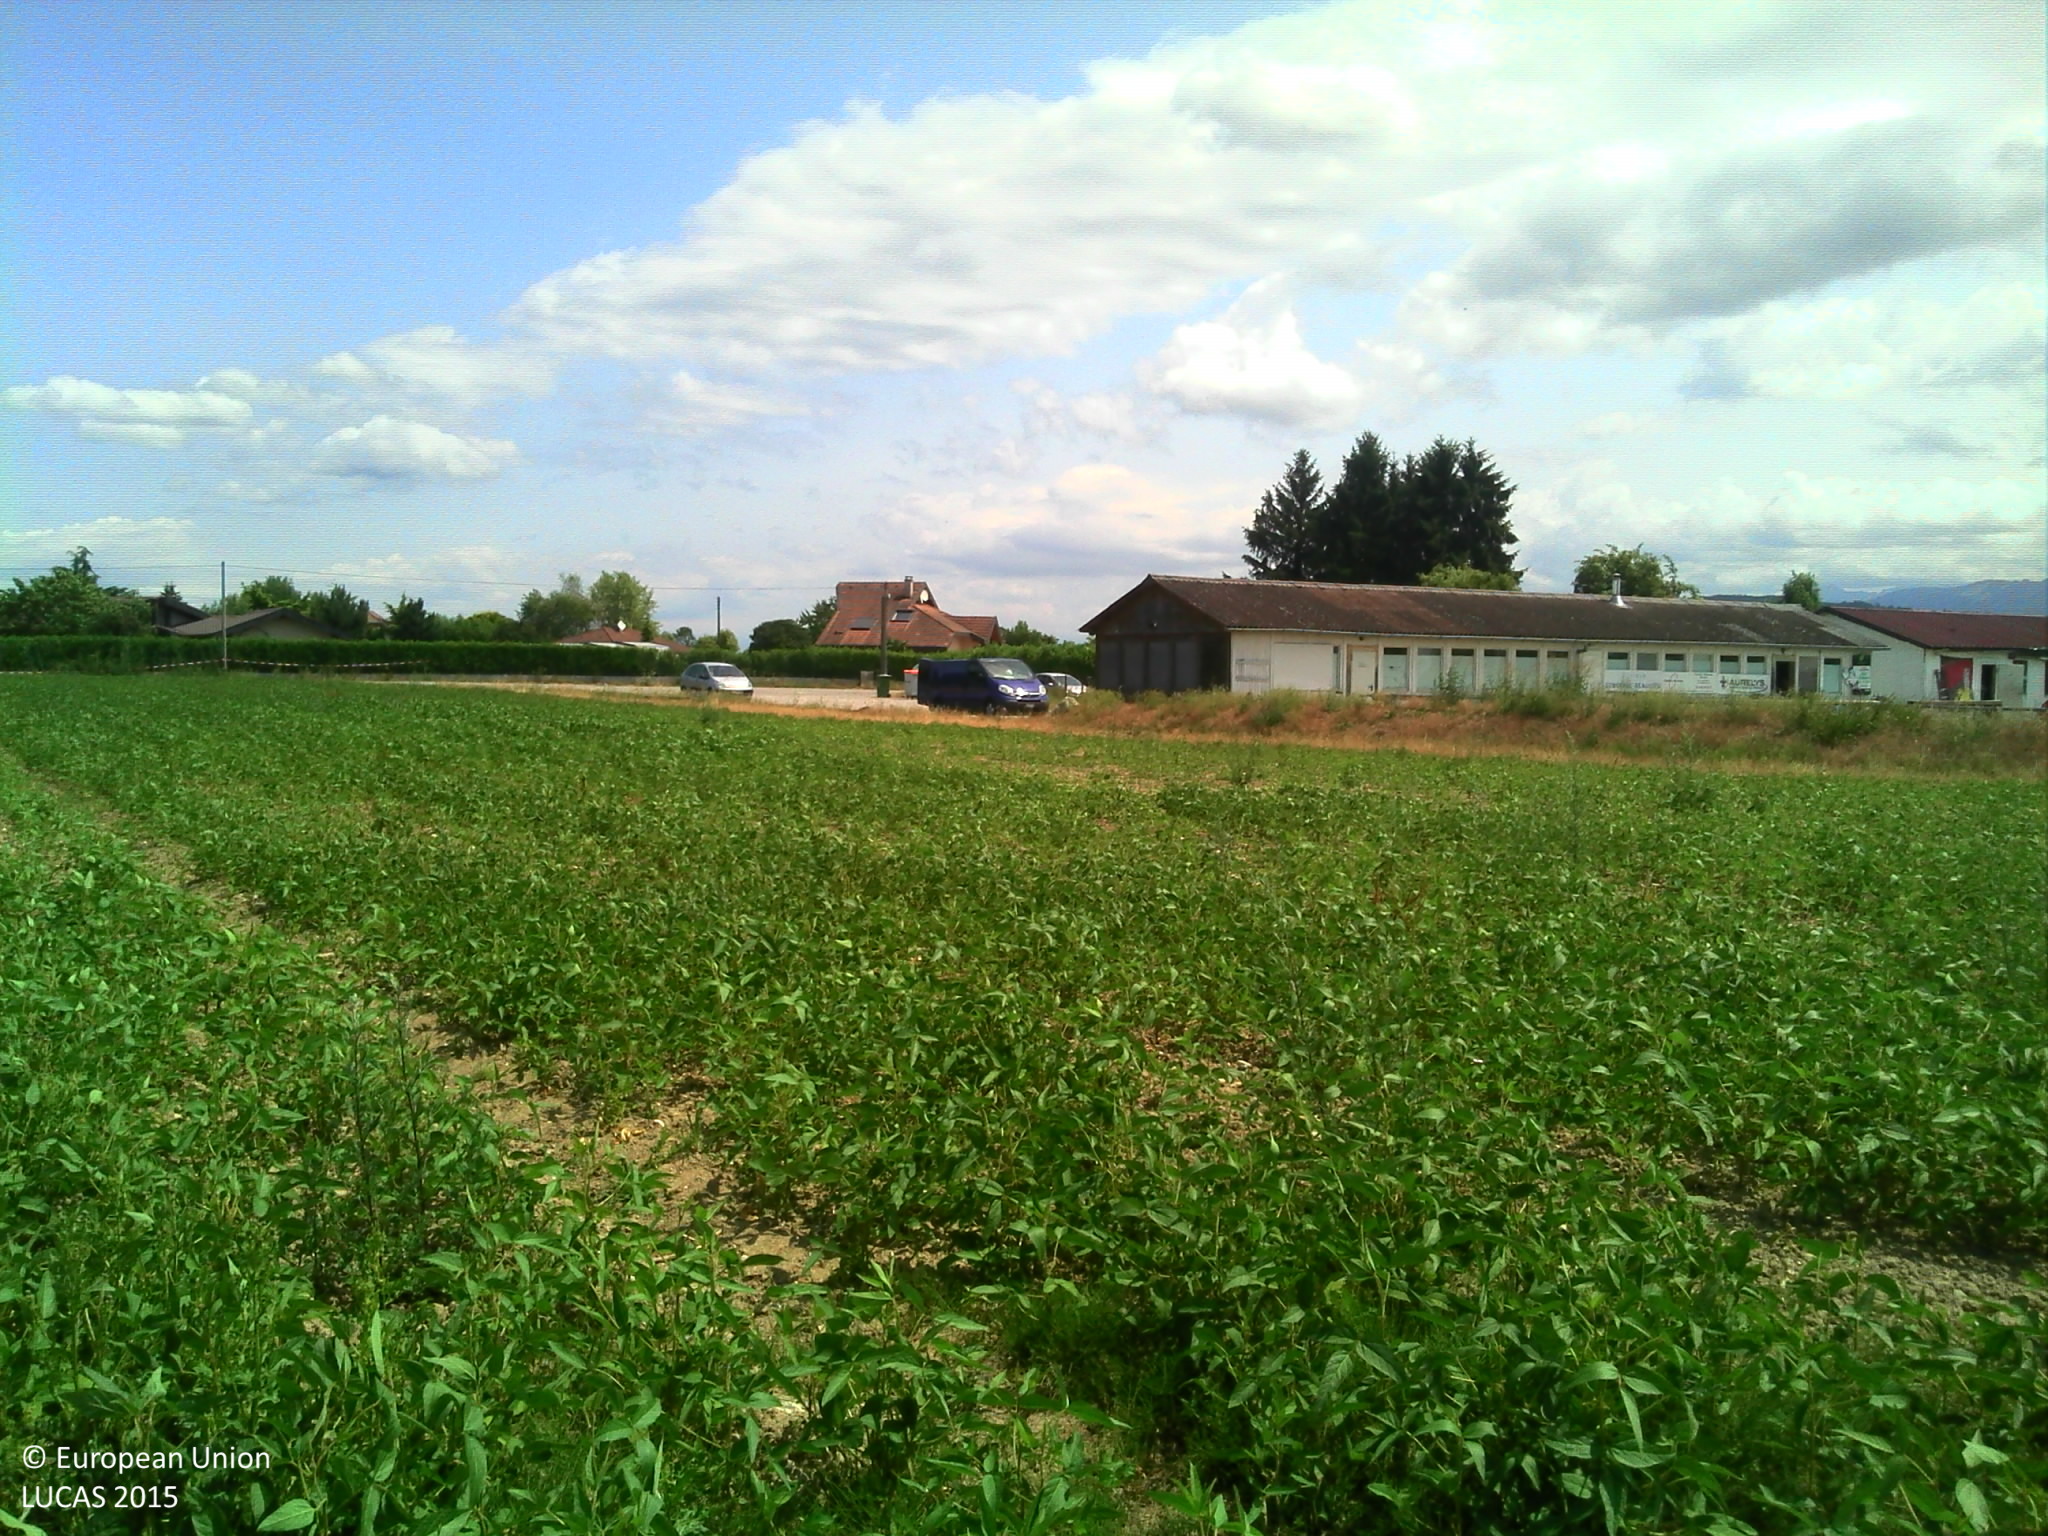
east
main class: Cropland
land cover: Soya
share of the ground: > 75 %
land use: Agriculture (excluding fallow land and kitchen gardens)
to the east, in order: Soya; Tracks; Spontaneously vegetated surfaces; Grass margins; Fences; Grassland without tree/shrub cover; Artificial constructions in urban areas; Grassland without tree/shrub cover; Tracks; Common wheat
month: July
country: FR
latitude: 46.3036
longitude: 6.2510
